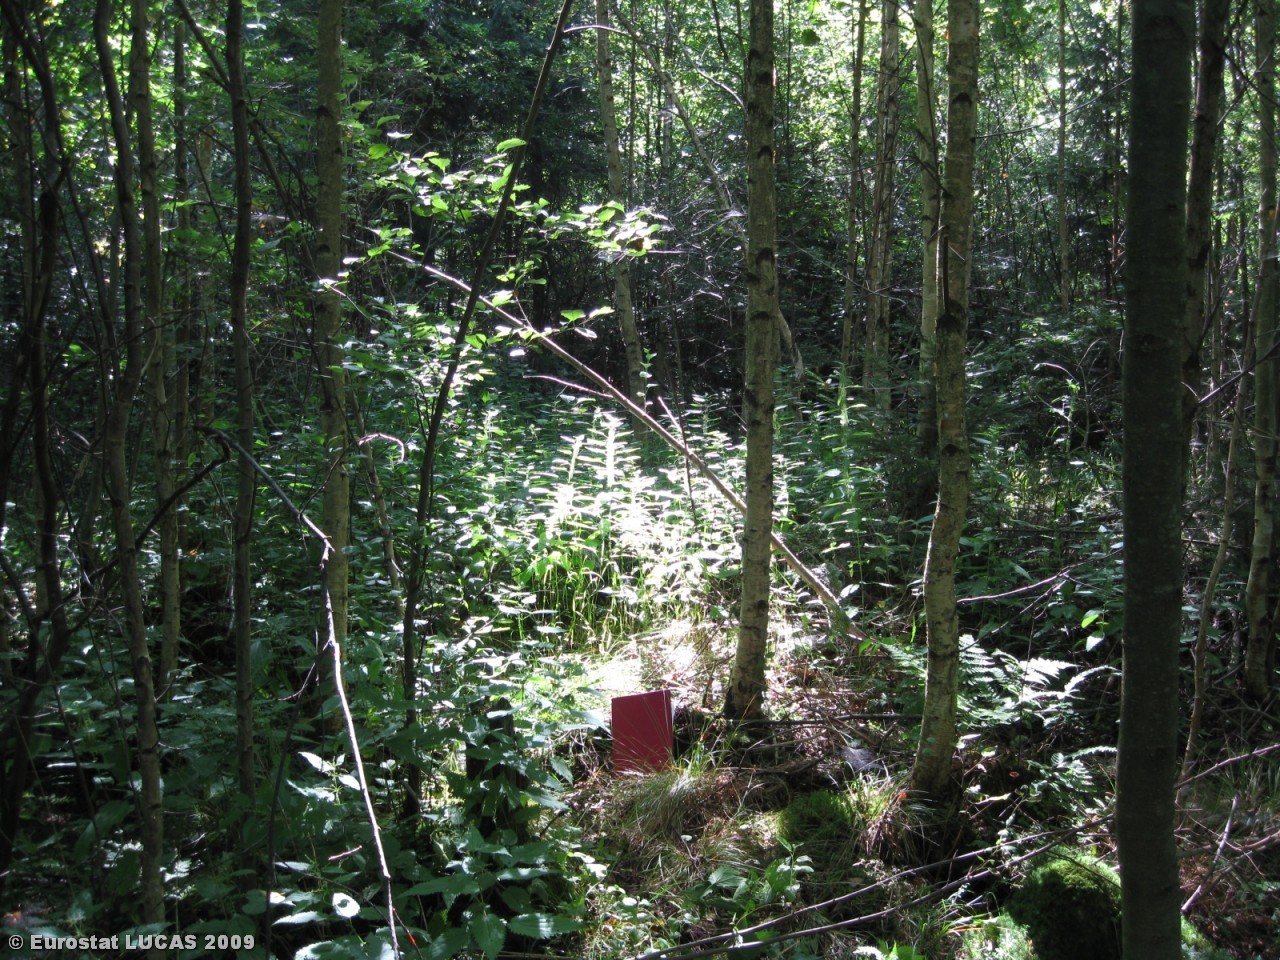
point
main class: Woodland
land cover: Broadleaved woodland
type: non-riverine alder, birch or aspen forest
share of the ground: > 75 %
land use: Forestry
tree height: > 5 m
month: August
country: LT
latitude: 54.7698
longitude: 23.5591
